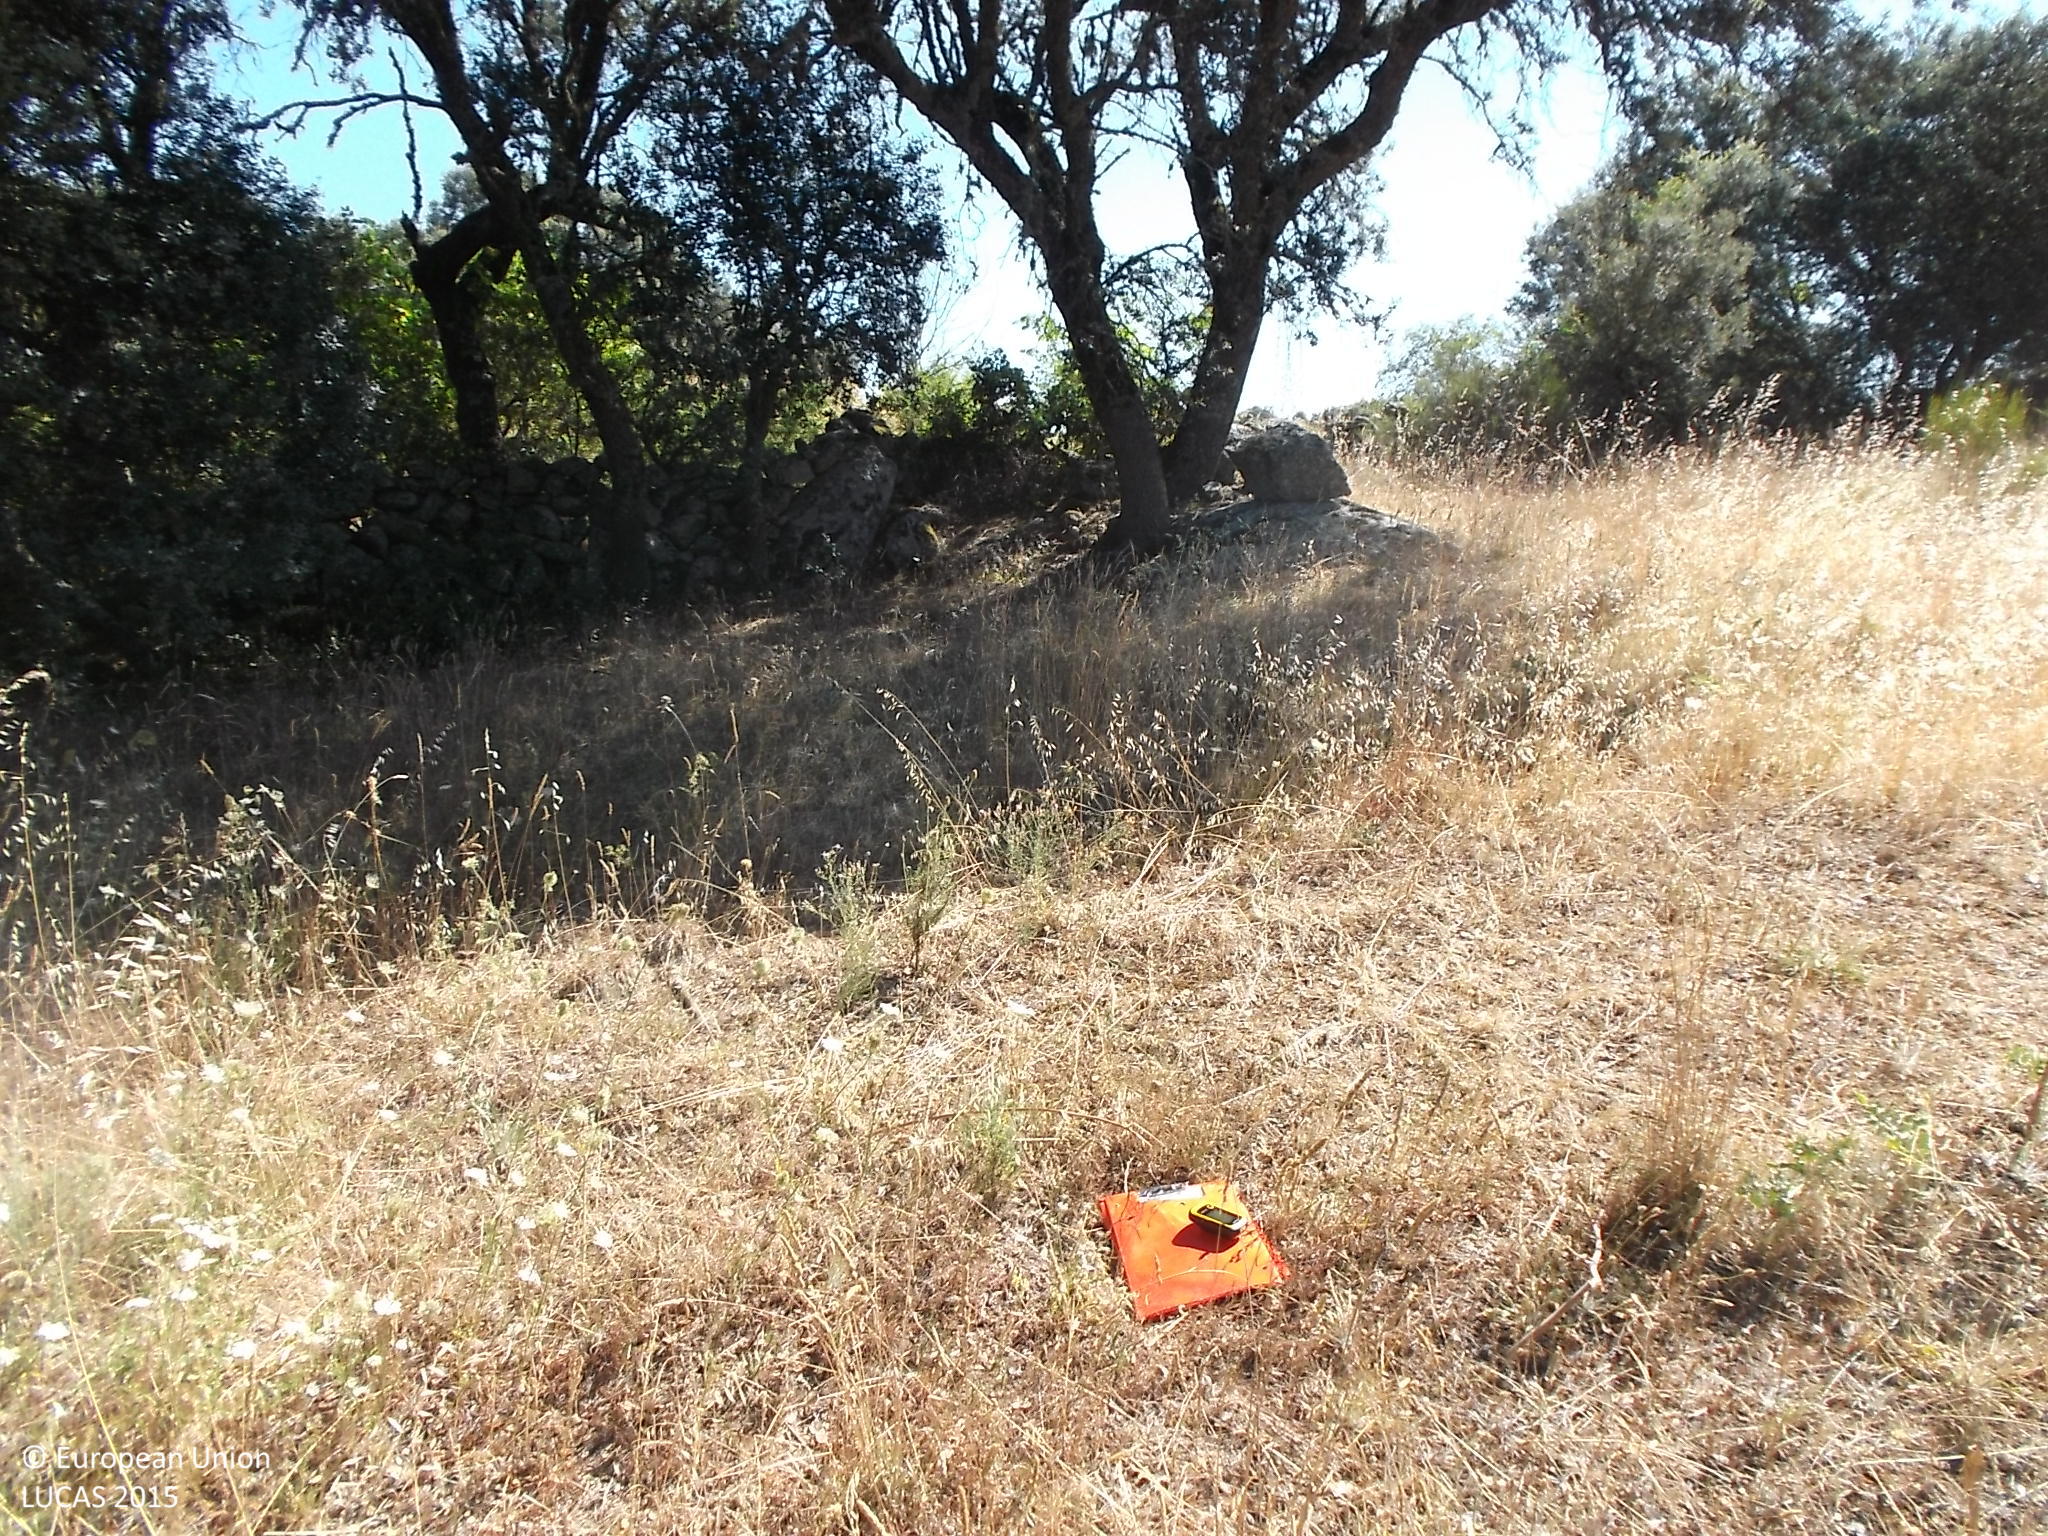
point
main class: Grassland
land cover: Grassland with sparse tree/shrub cover
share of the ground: > 75 %
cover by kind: herbaceous plants 90 %, broadleaved forest trees 5 %, shrubs 5 %
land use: Agriculture (excluding fallow land and kitchen gardens)
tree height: > 5 m
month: July
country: ES
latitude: 41.5014
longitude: -6.1110
